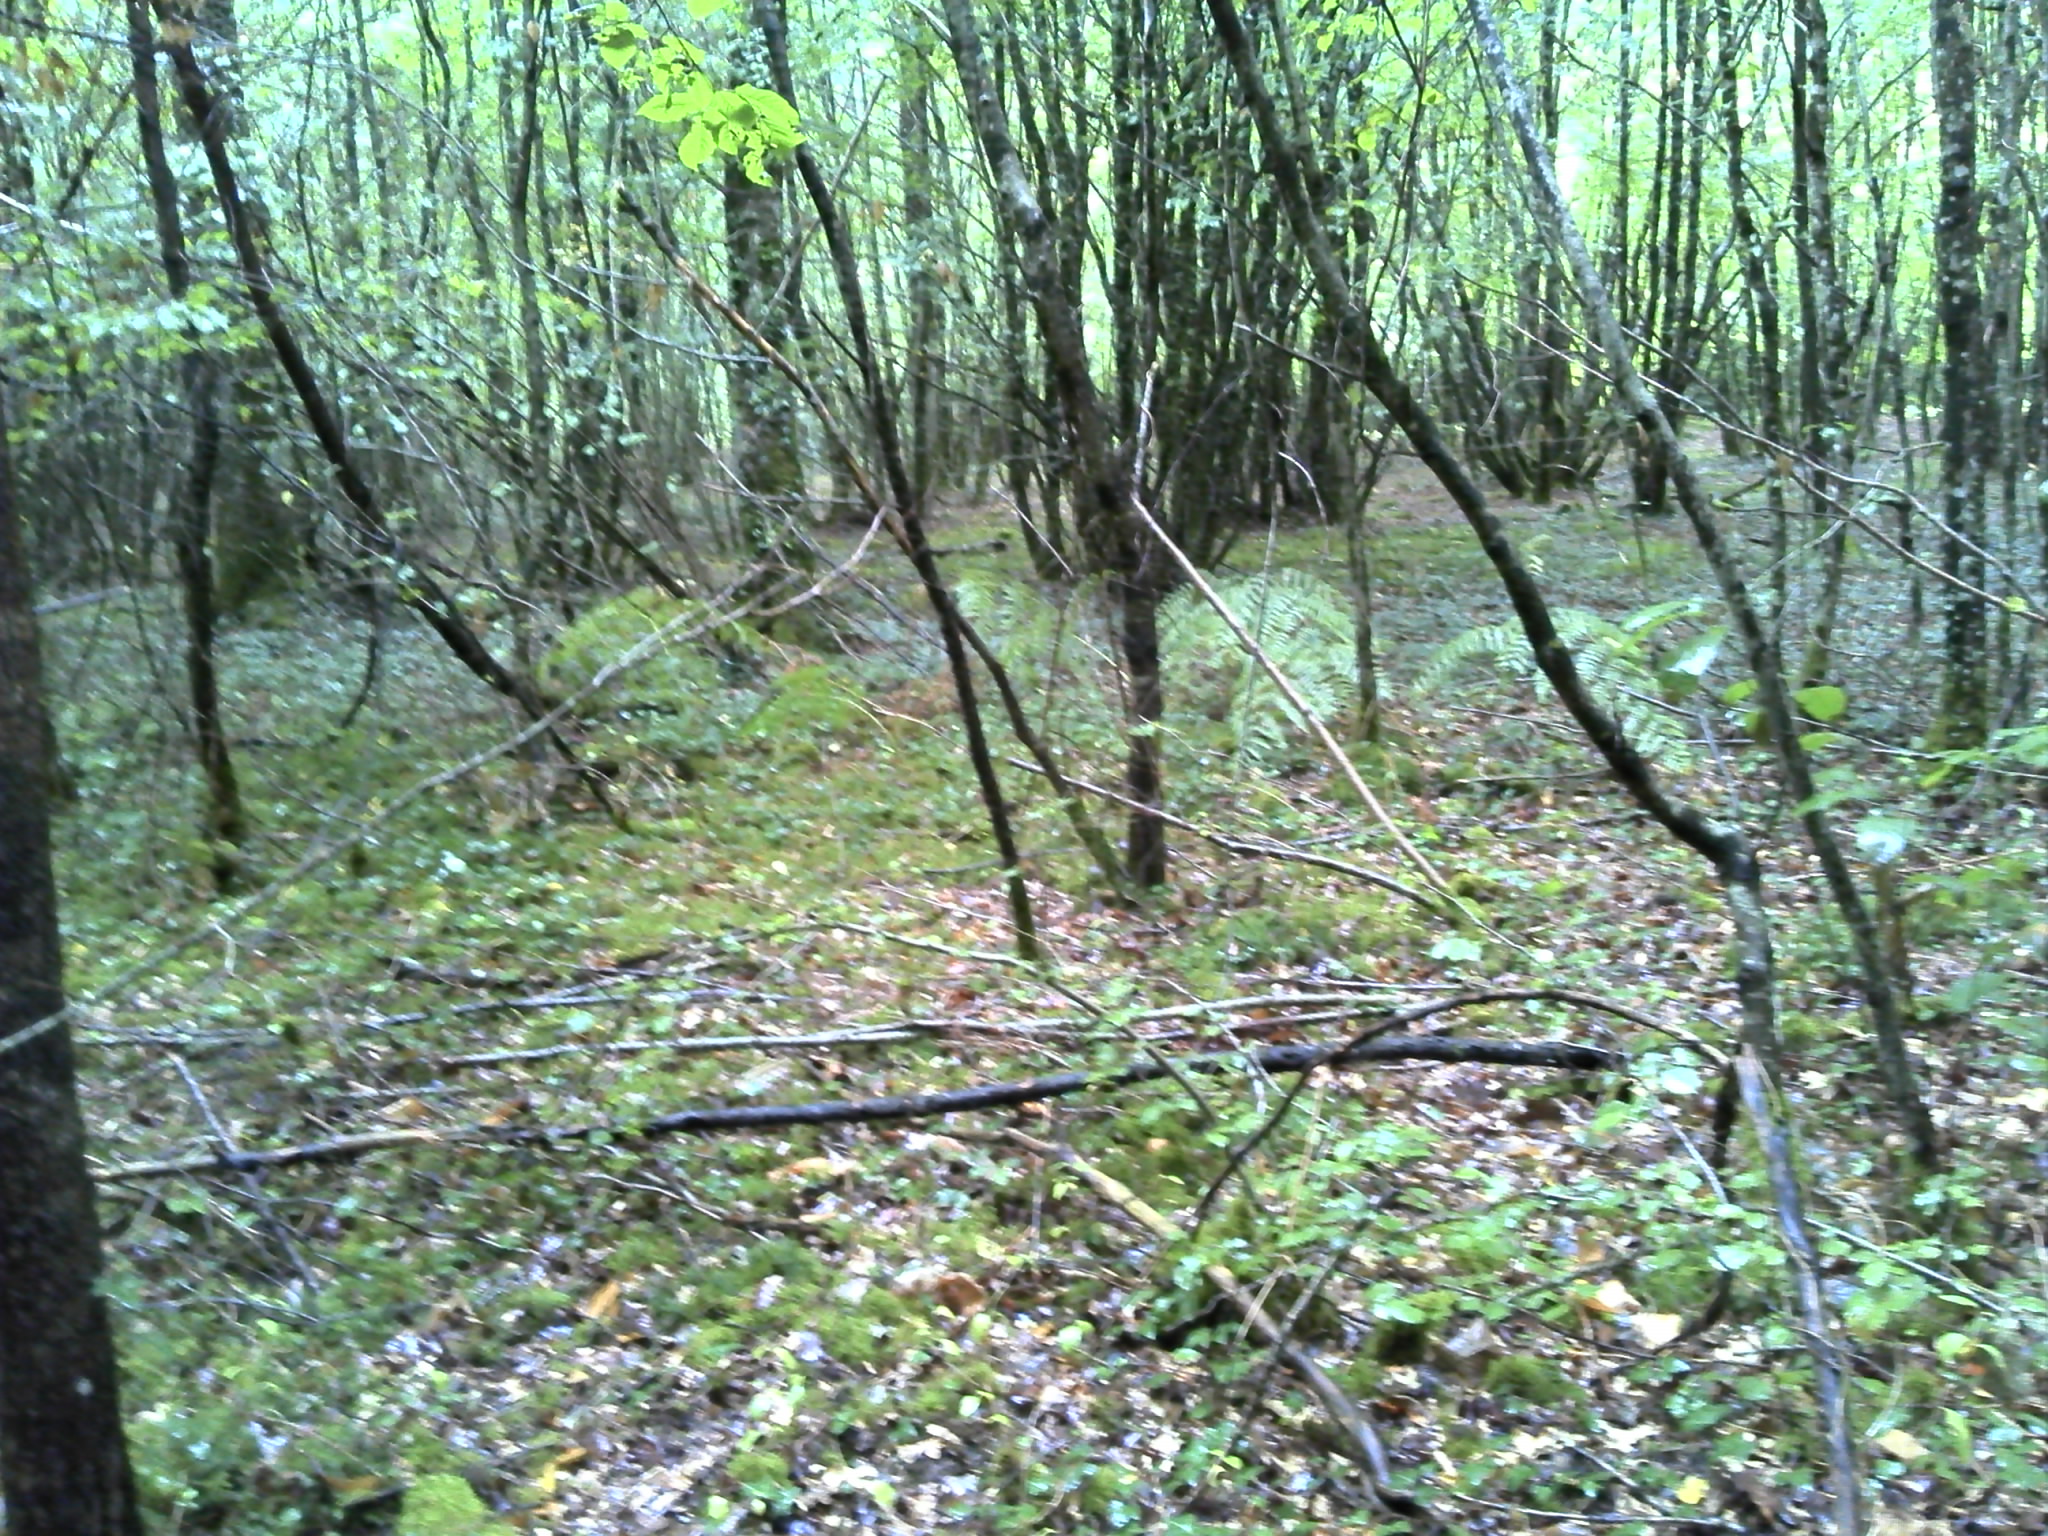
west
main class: Woodland
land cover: Broadleaved woodland
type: mesophytic deciduous forest
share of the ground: > 75 %
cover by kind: broadleaved forest trees 95 %, herbaceous plants 5 %
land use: Forestry
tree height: > 5 m
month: August
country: FR
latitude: 46.7225
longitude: 1.5502
